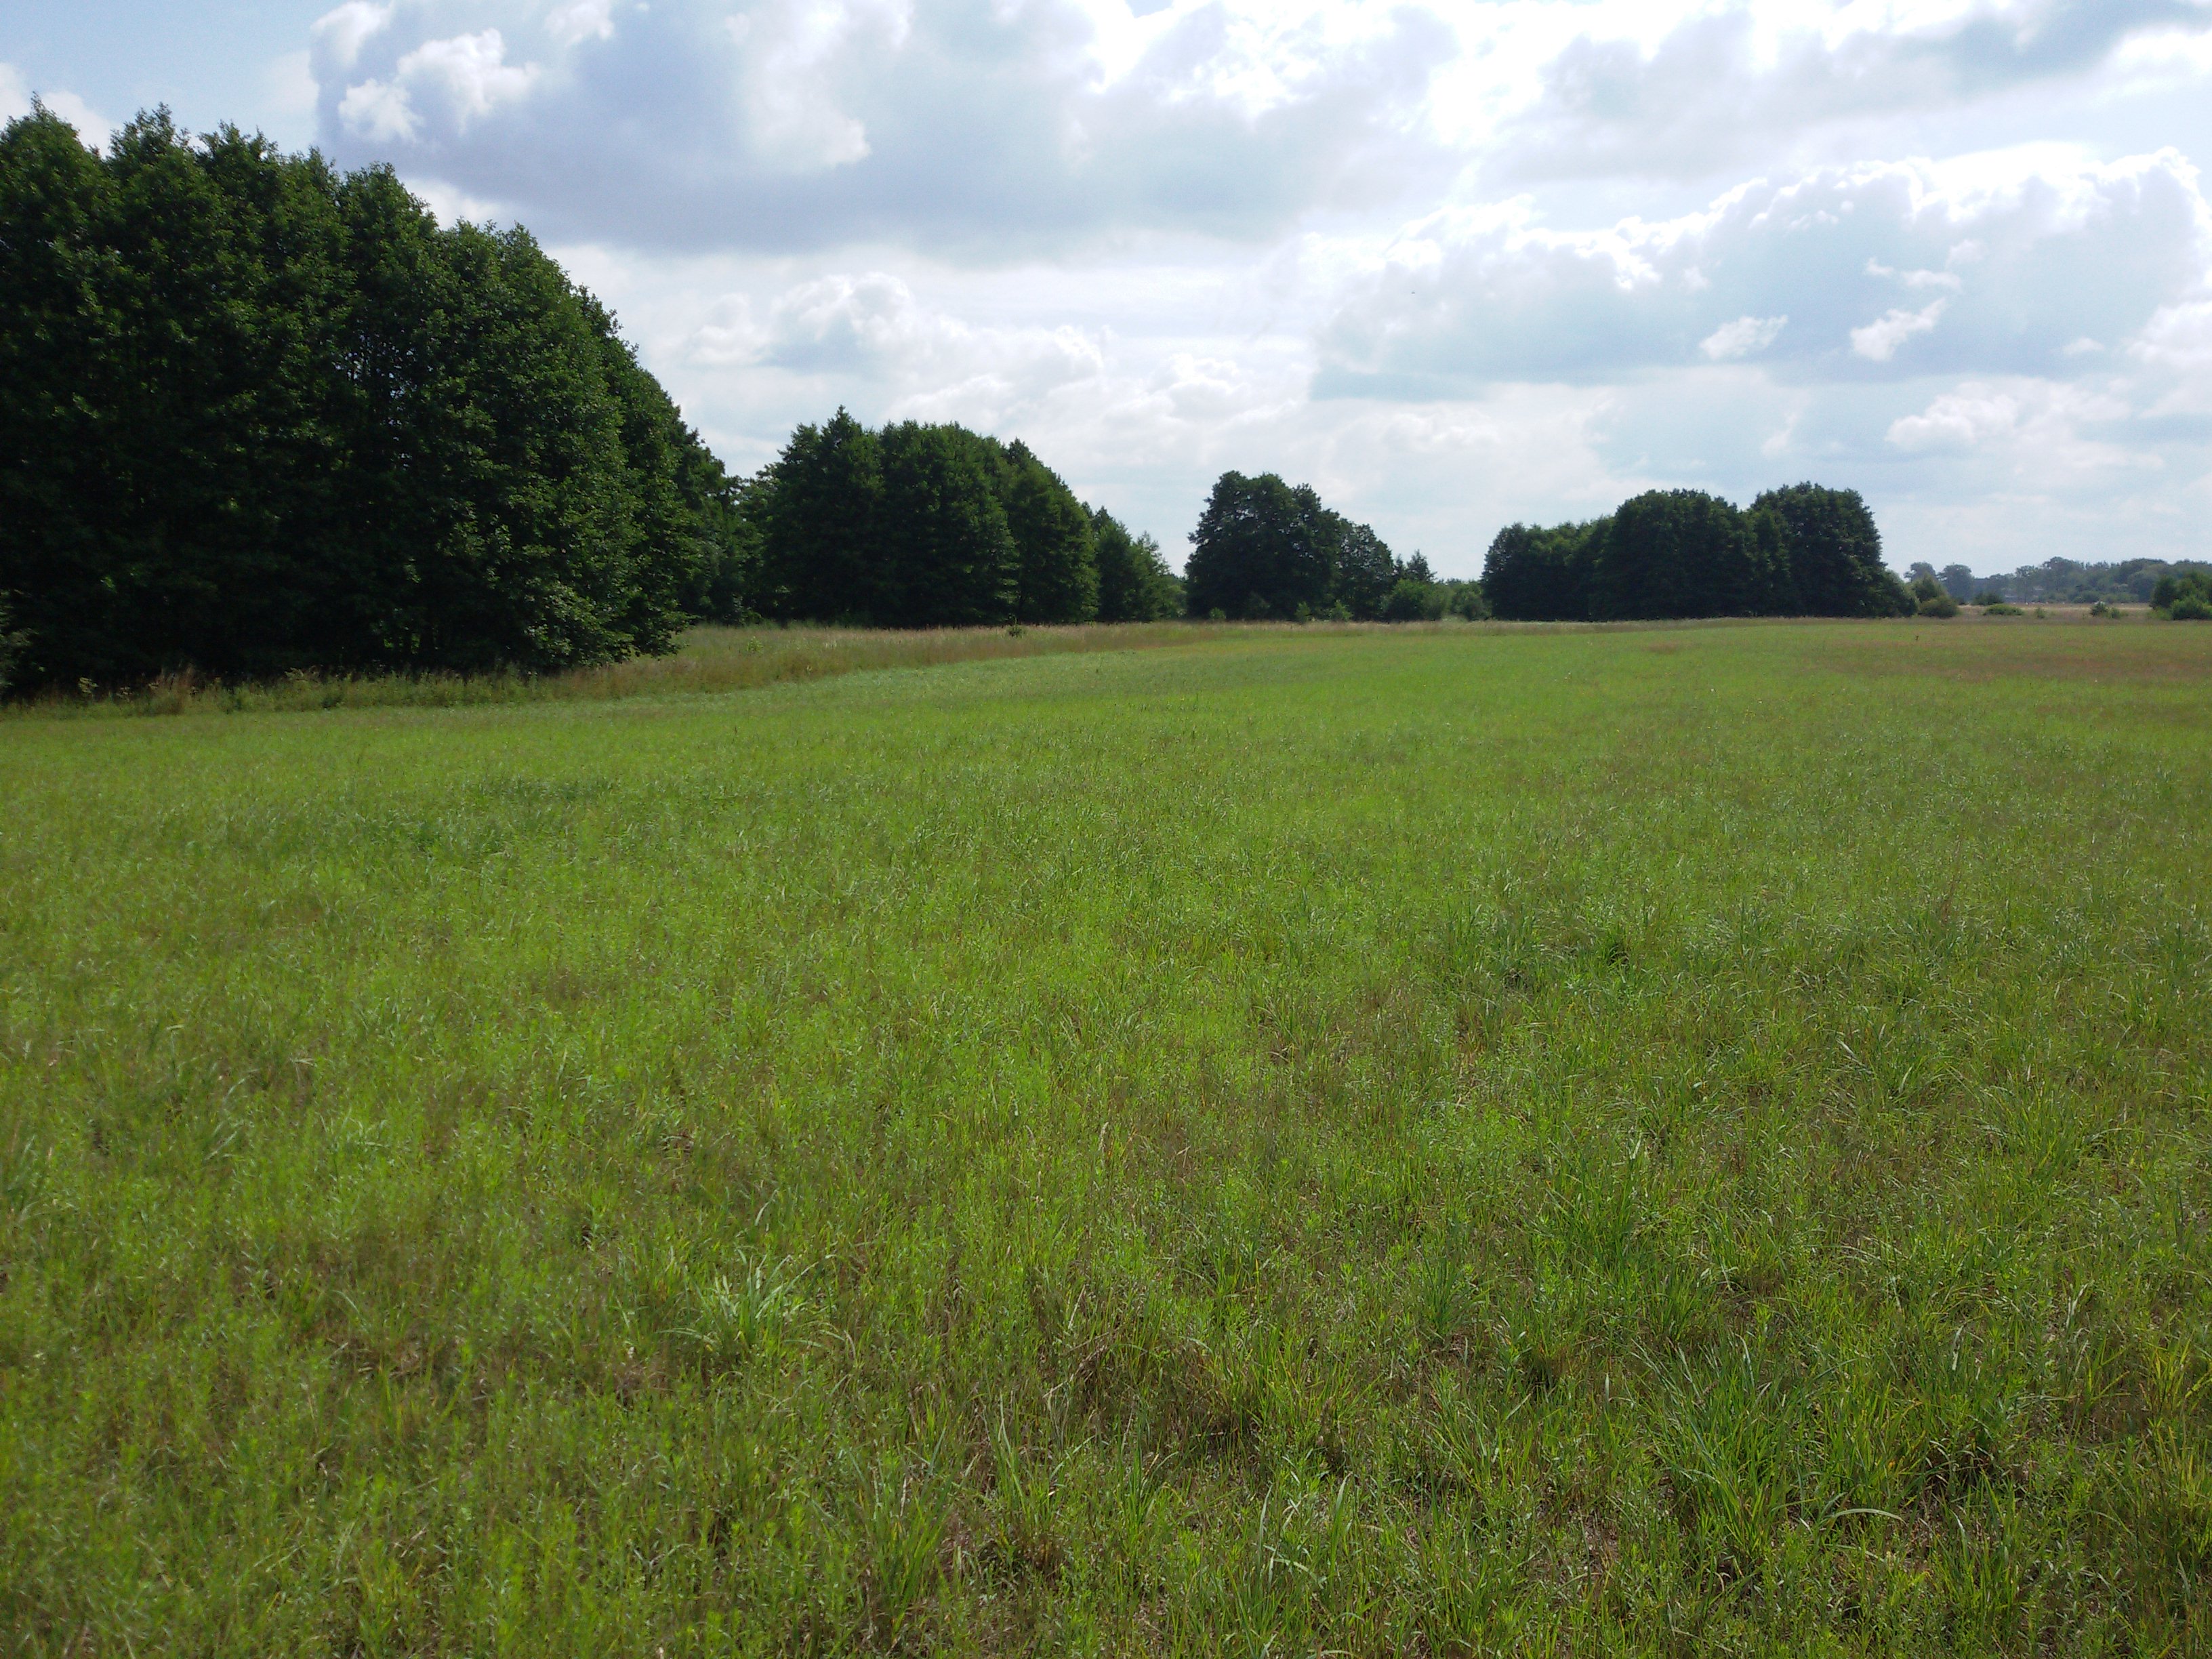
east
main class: Grassland
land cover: Grassland without tree/shrub cover
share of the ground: > 75 %
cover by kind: herbaceous plants 100 %
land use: Agriculture (excluding fallow land and kitchen gardens)
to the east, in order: Grassland without tree/shrub cover; Spontaneously vegetated surfaces; Broadleaved woodland; Ditches and canals; Shrubland with sparse tree cover; Spontaneously vegetated surfaces
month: July
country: PL
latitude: 52.5384
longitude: 17.1909
